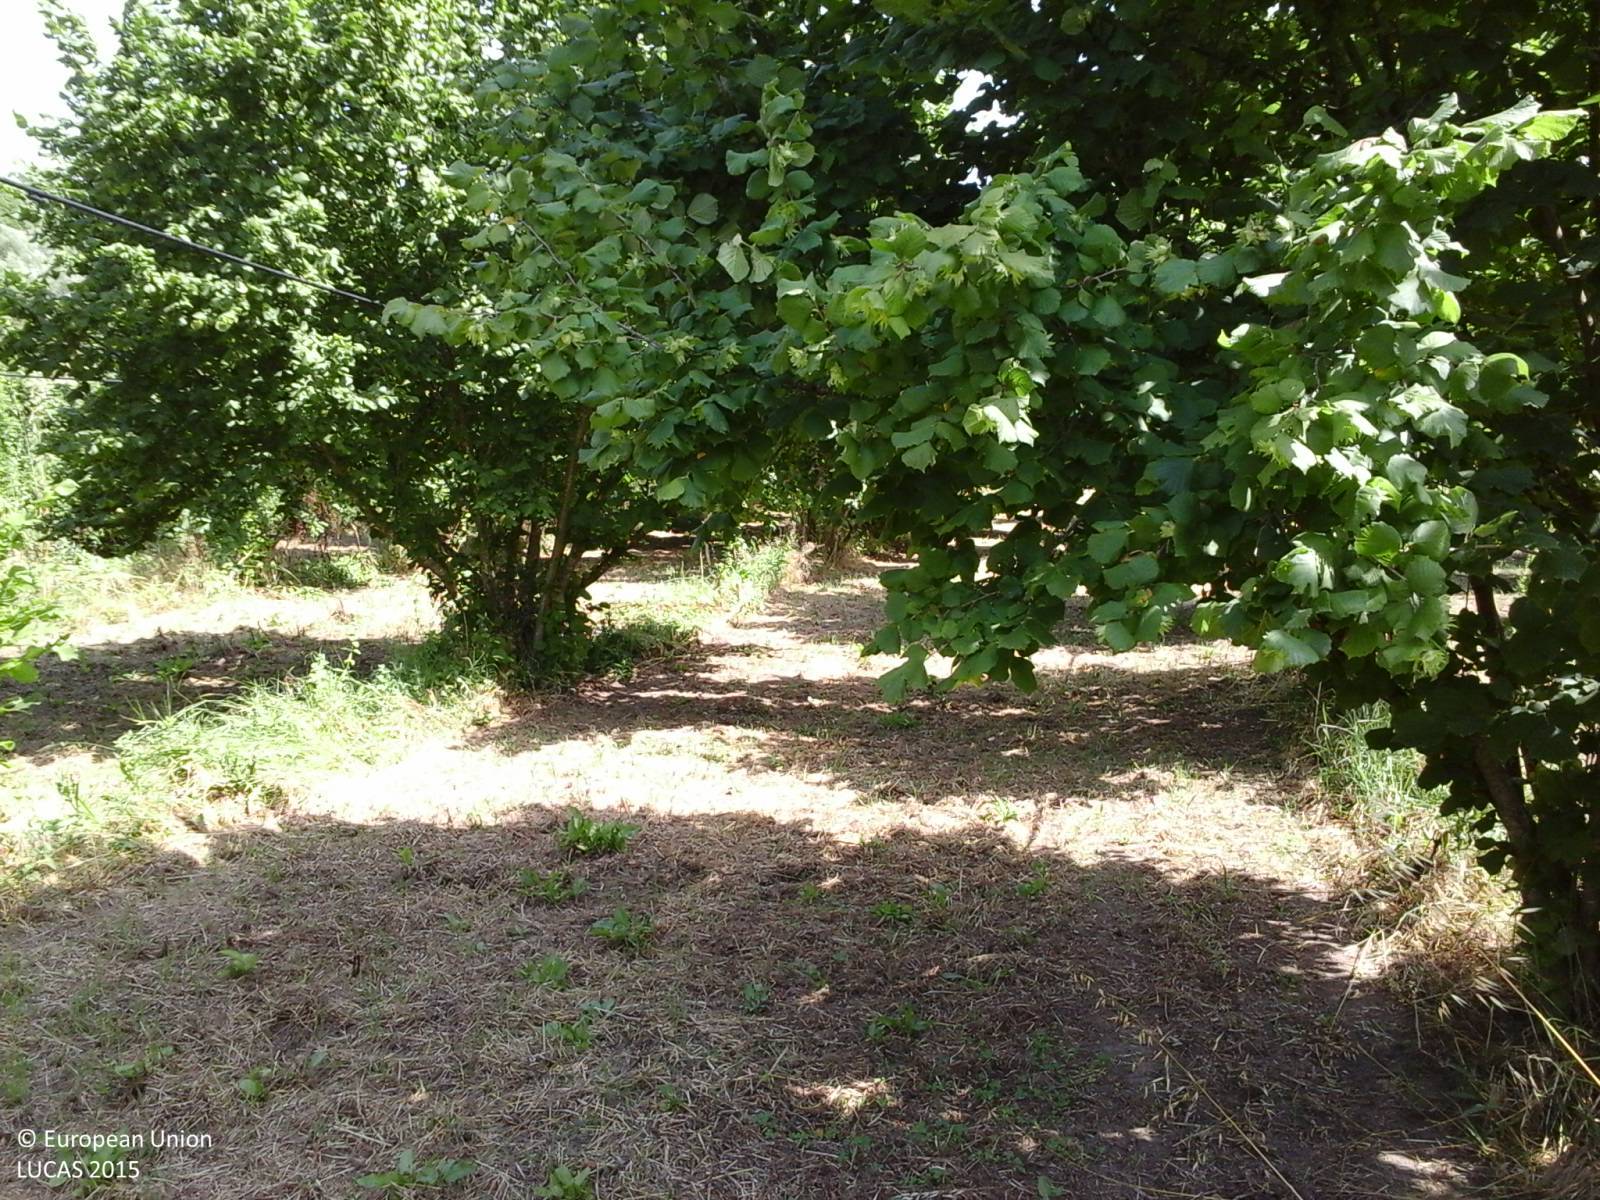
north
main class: Cropland
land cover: Nuts trees
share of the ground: > 75 %
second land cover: Grassland without tree/shrub cover
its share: > 75 %
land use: Agriculture (excluding fallow land and kitchen gardens)
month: June
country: IT
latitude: 42.4305
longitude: 12.2411
